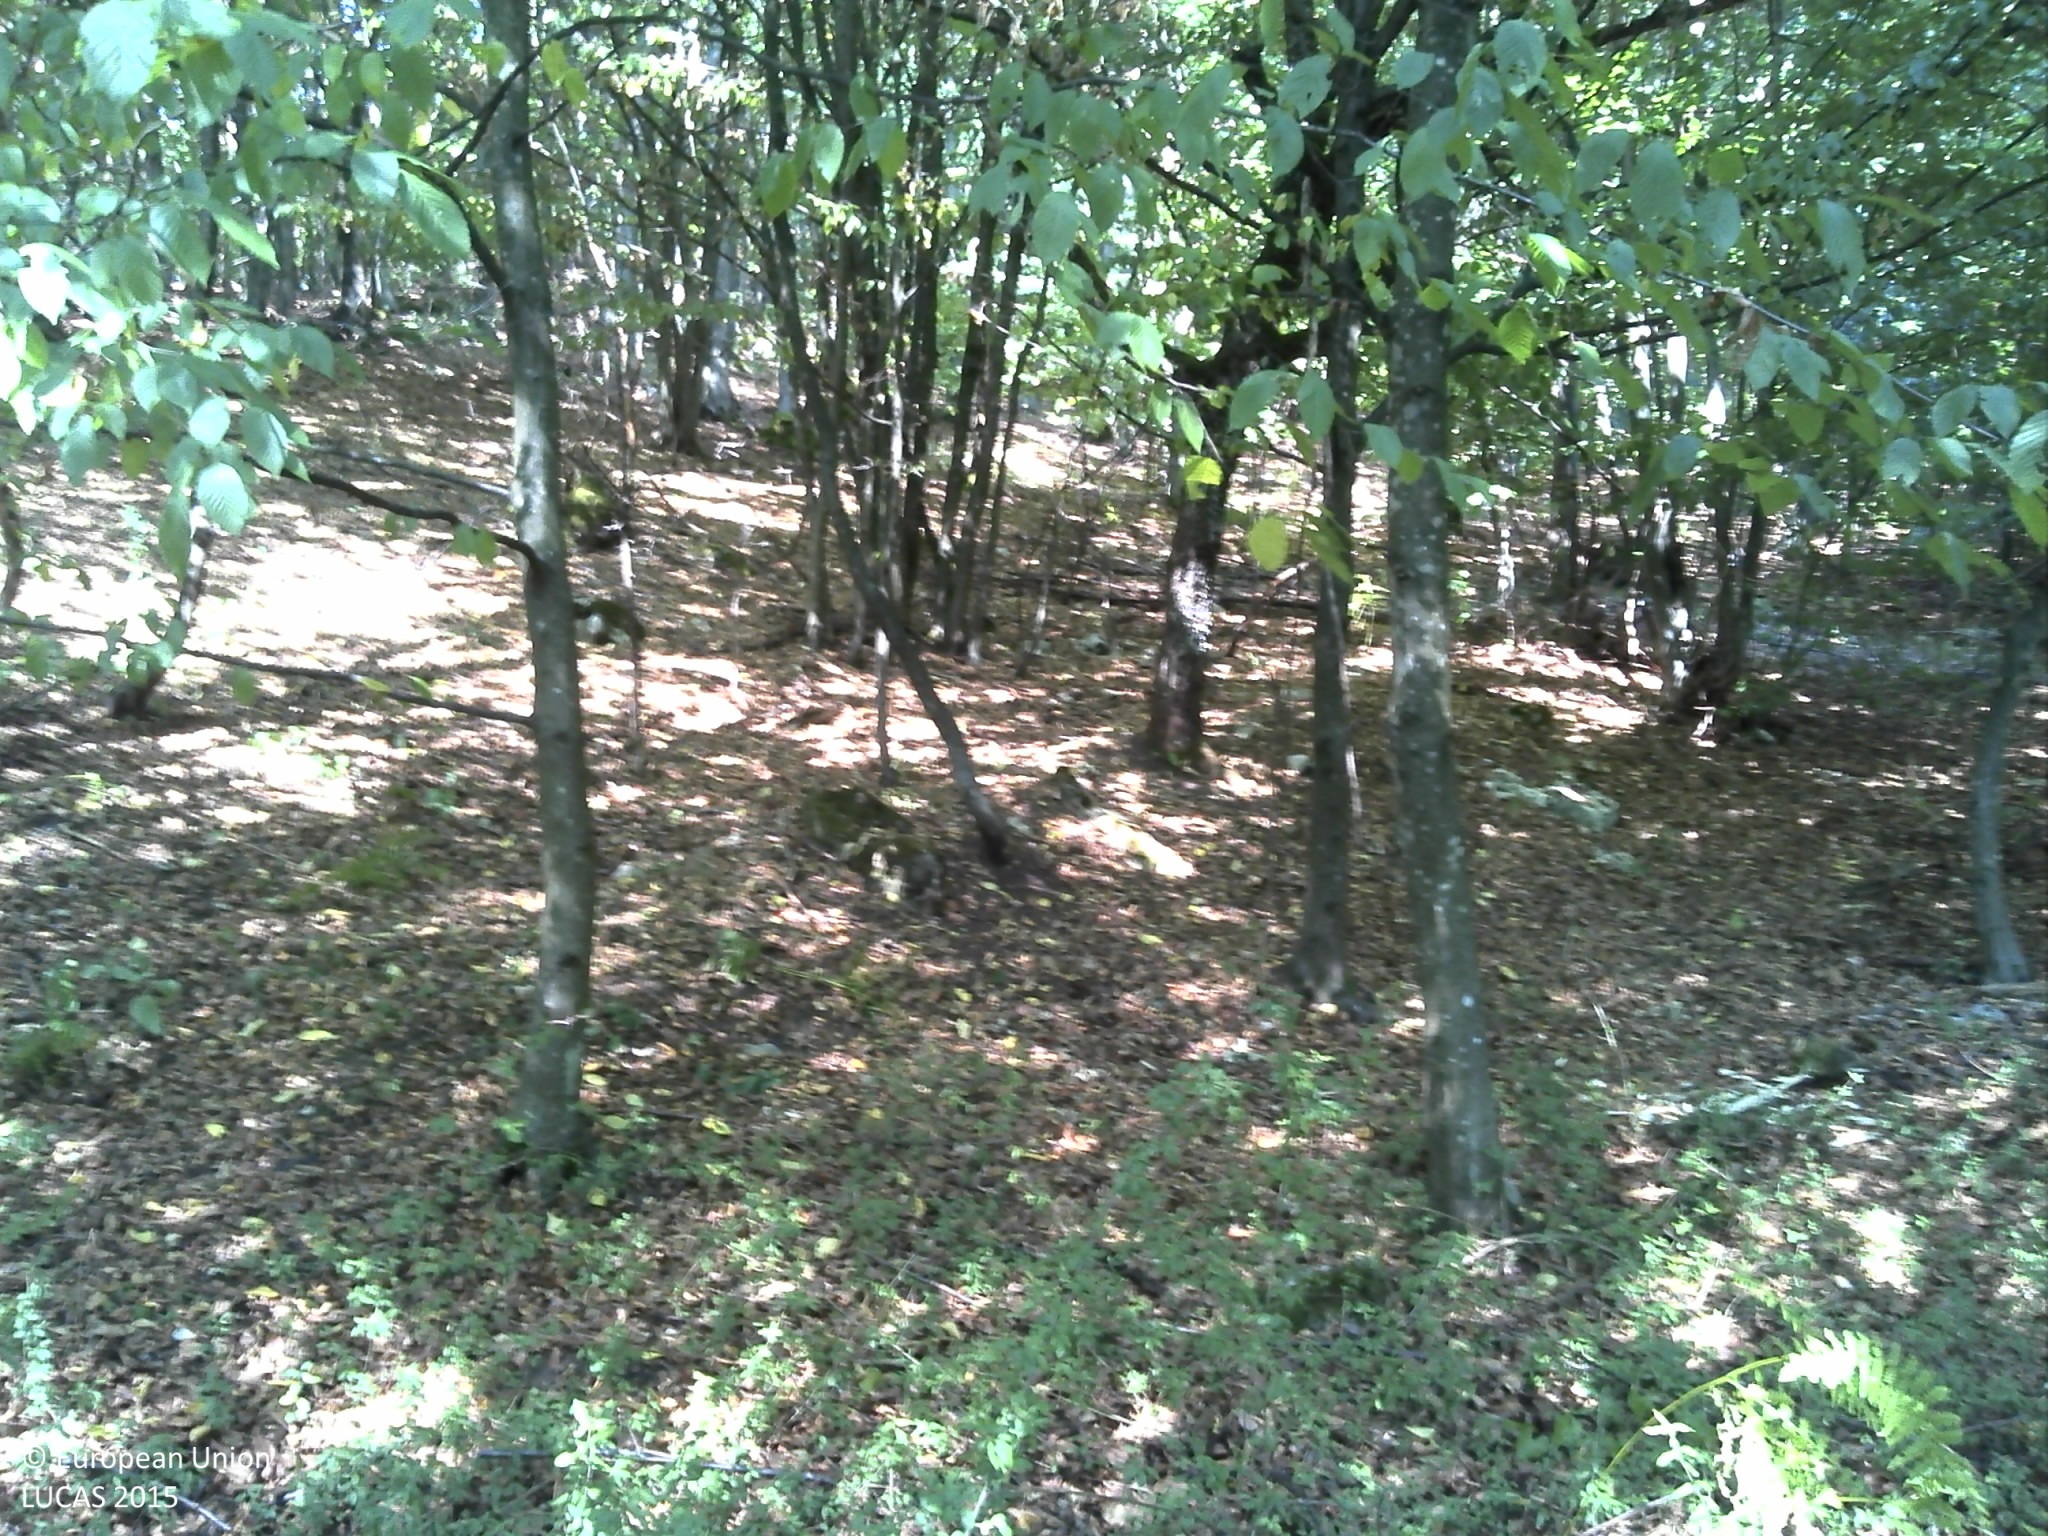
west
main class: Woodland
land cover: Broadleaved woodland
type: beech forest
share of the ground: > 75 %
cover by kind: broadleaved forest trees 100 %
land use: Forestry
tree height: > 5 m
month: August
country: HR
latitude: 45.5723
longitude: 17.3693
